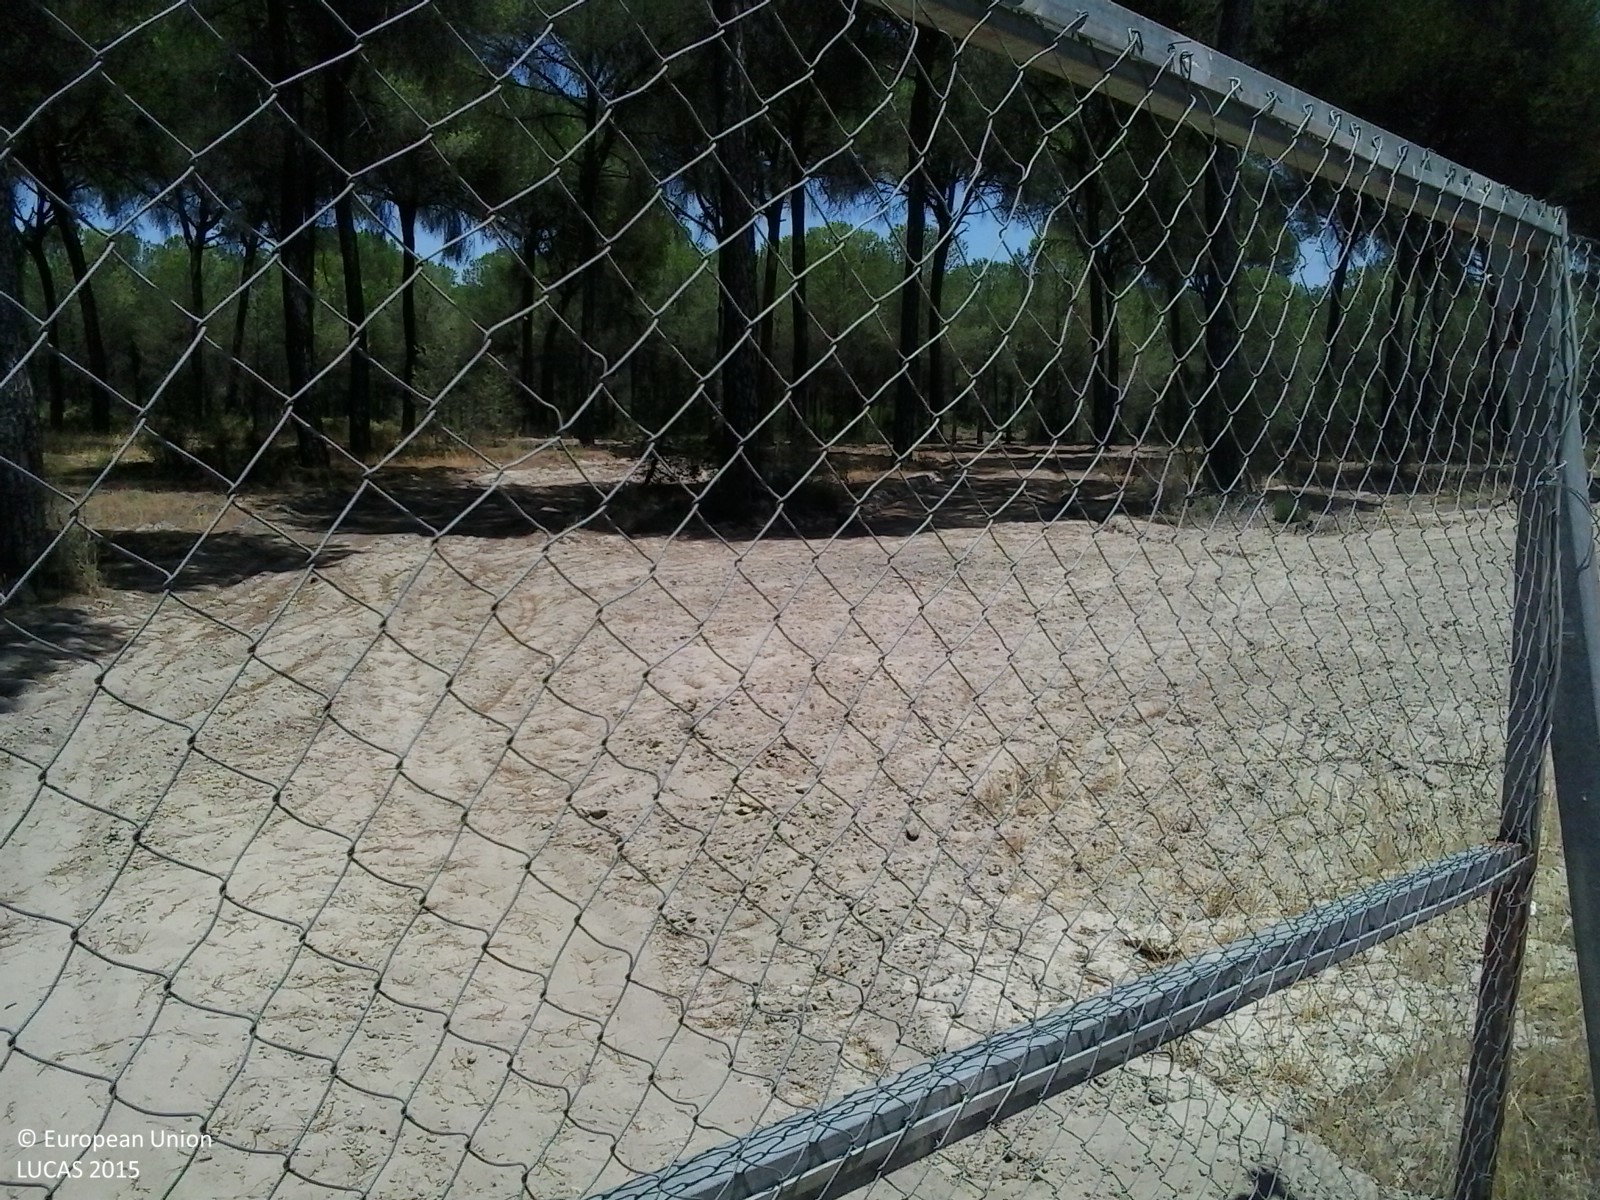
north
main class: Woodland
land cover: Pine dominated coniferous woodland
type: coniferous forest of the mediterranean region
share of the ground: 50 - 75 %
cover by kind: coniferous forest trees 50 %, herbaceous plants 30 %, shrubs 20 %
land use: Forestry
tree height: > 5 m
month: July
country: ES
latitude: 37.2034
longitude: -6.3751
